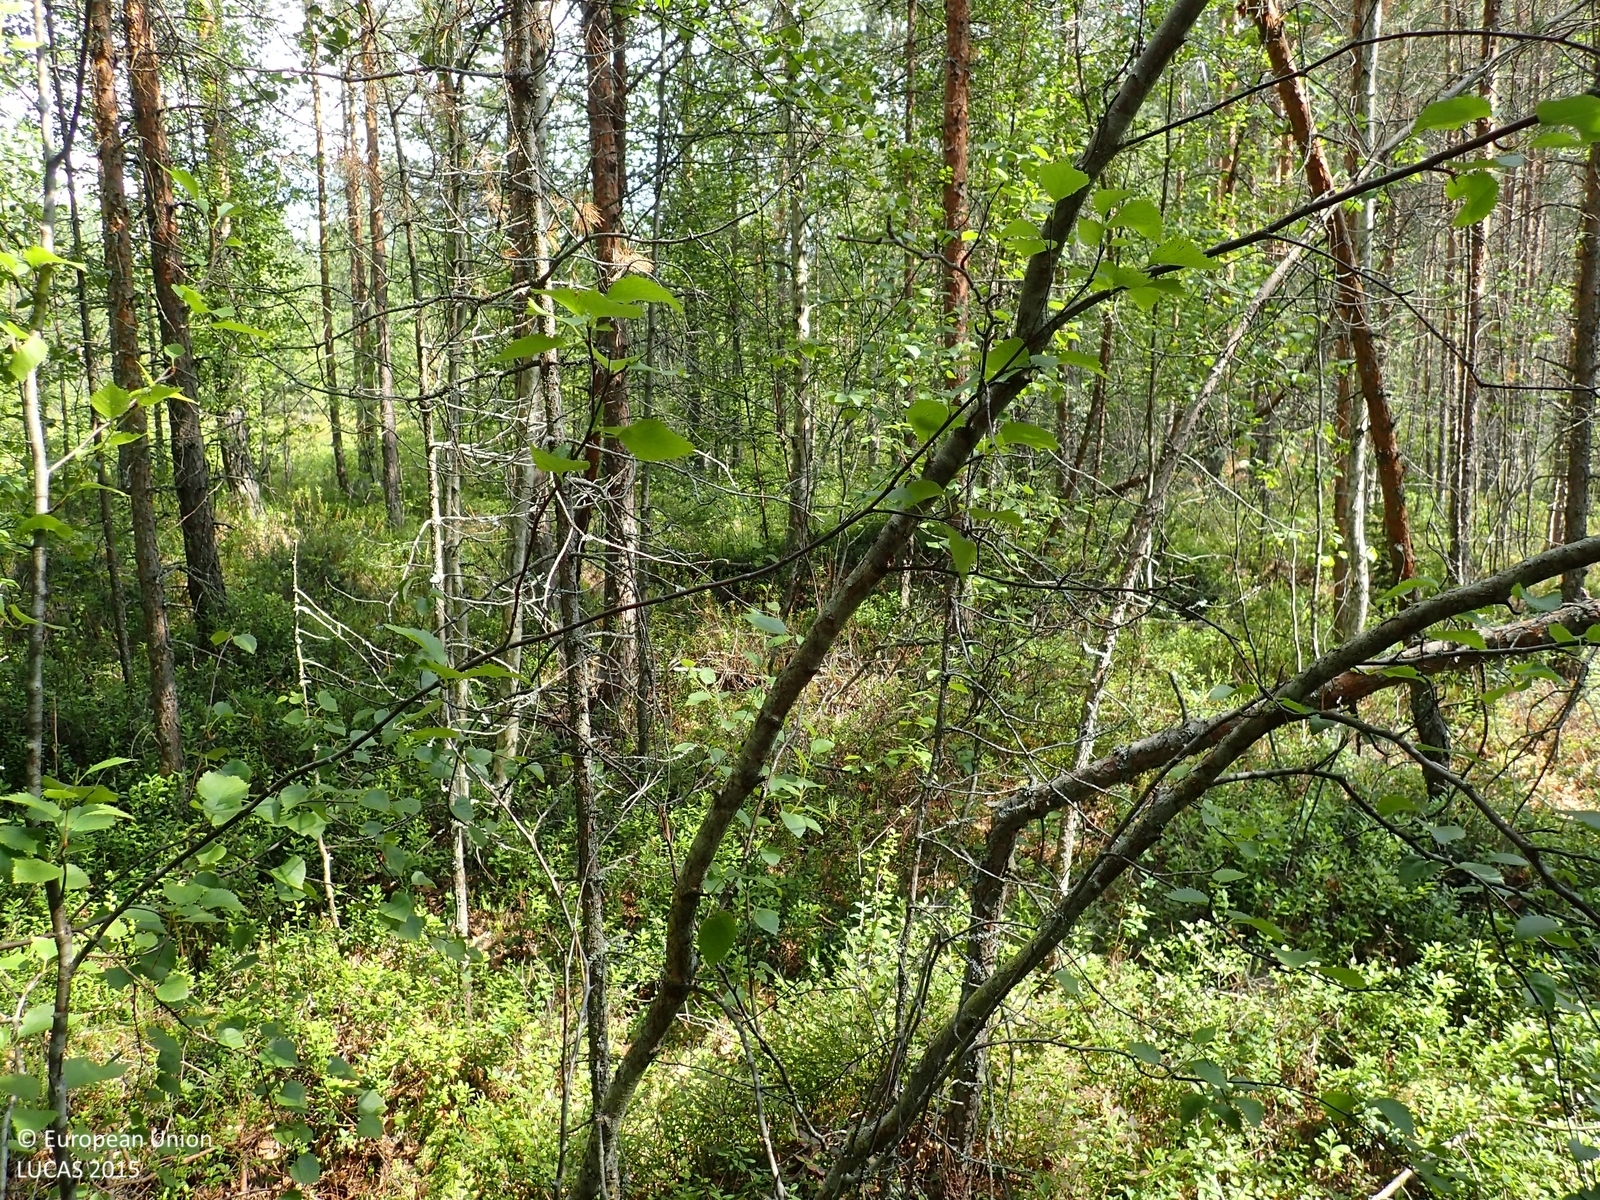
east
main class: Woodland
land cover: Pine dominated coniferous woodland
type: boreal forest
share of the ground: > 75 %
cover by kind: coniferous forest trees 70 %, shrubs 20 %, broadleaved forest trees 10 %
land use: Forestry
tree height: > 5 m
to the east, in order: Pine dominated coniferous woodland; Ditches and canals; Pine dominated mixed woodland; Ditches and canals; Pine dominated mixed woodland; Grass margins; Paved roads, cycling and walking lanes; Grass margins; Abandoned hedges; Ditches and canals; Abandoned hedges; Pine dominated coniferous woodland
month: July
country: FI
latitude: 62.7056
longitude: 23.6175
